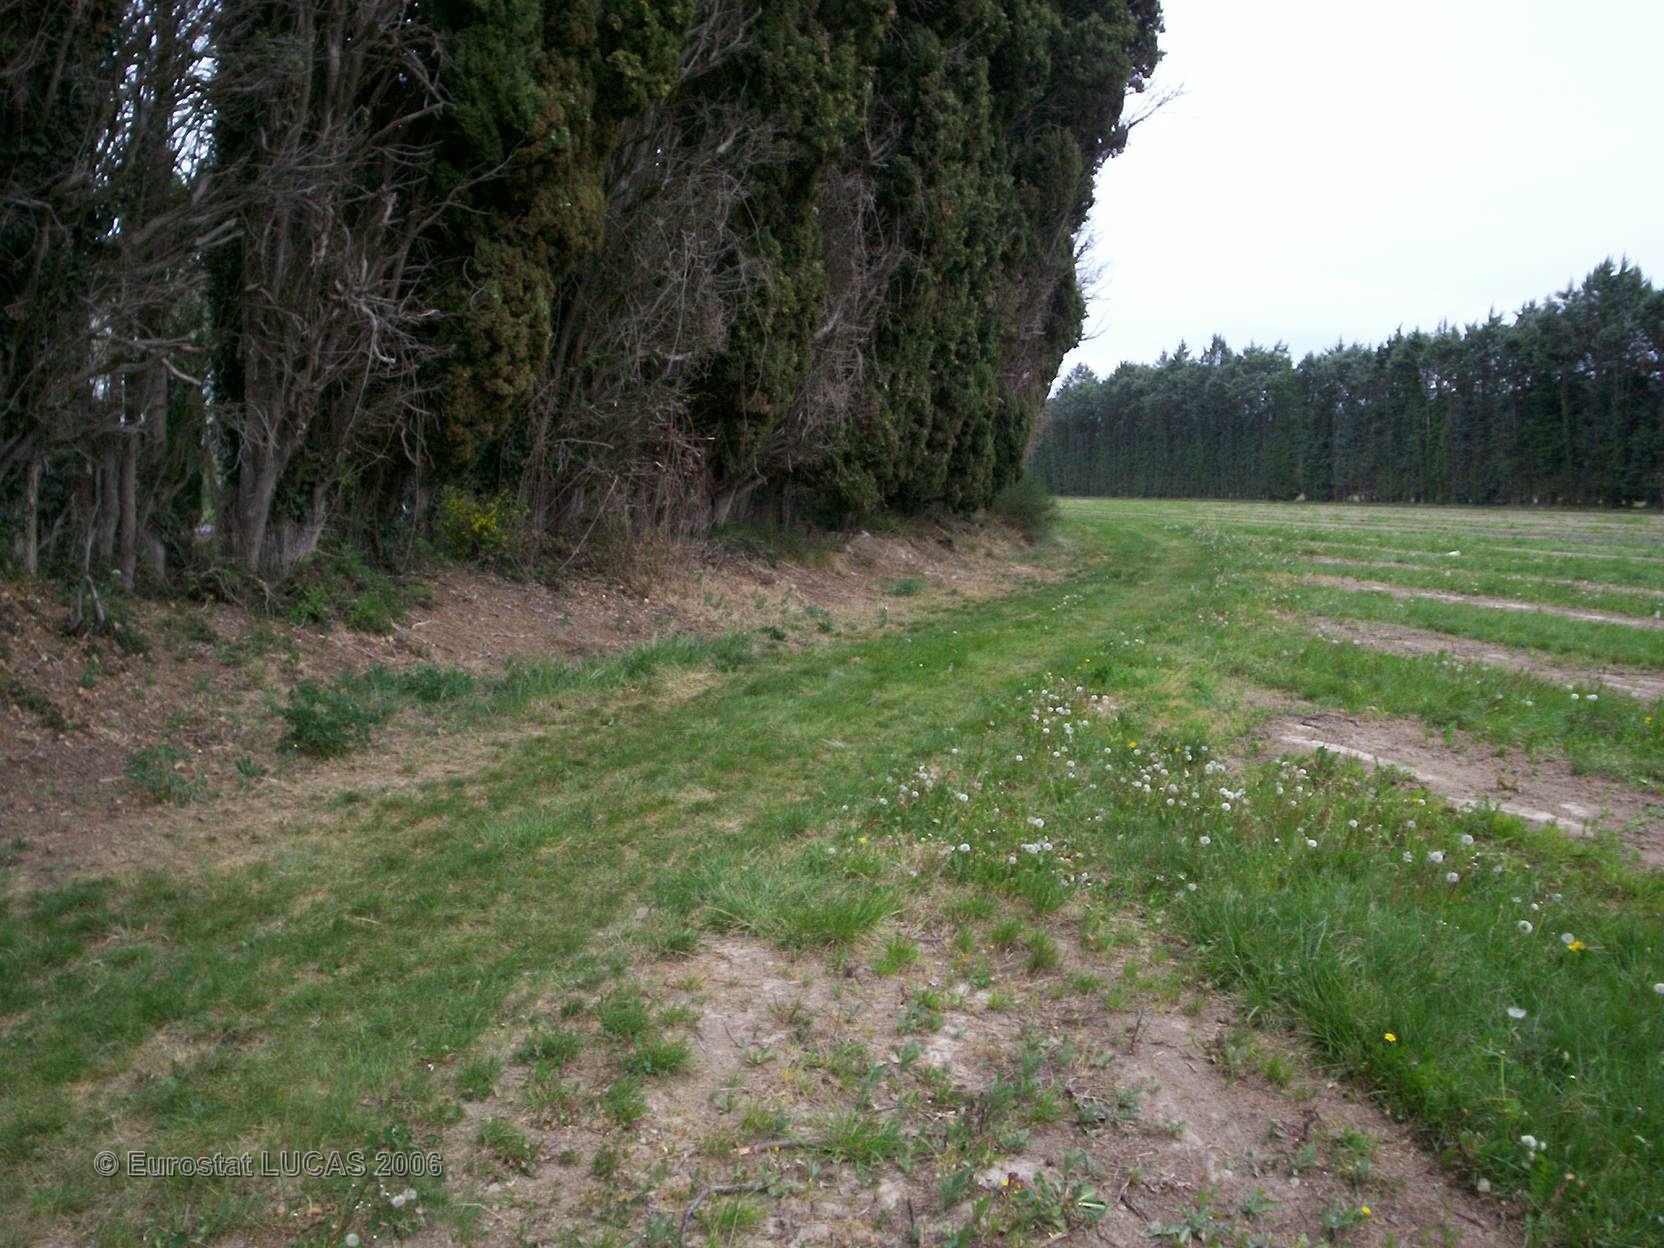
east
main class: Grassland
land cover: Grassland without tree/shrub cover
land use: Agriculture (excluding fallow land and kitchen gardens)
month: April
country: FR
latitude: 43.8312
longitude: 4.9725
